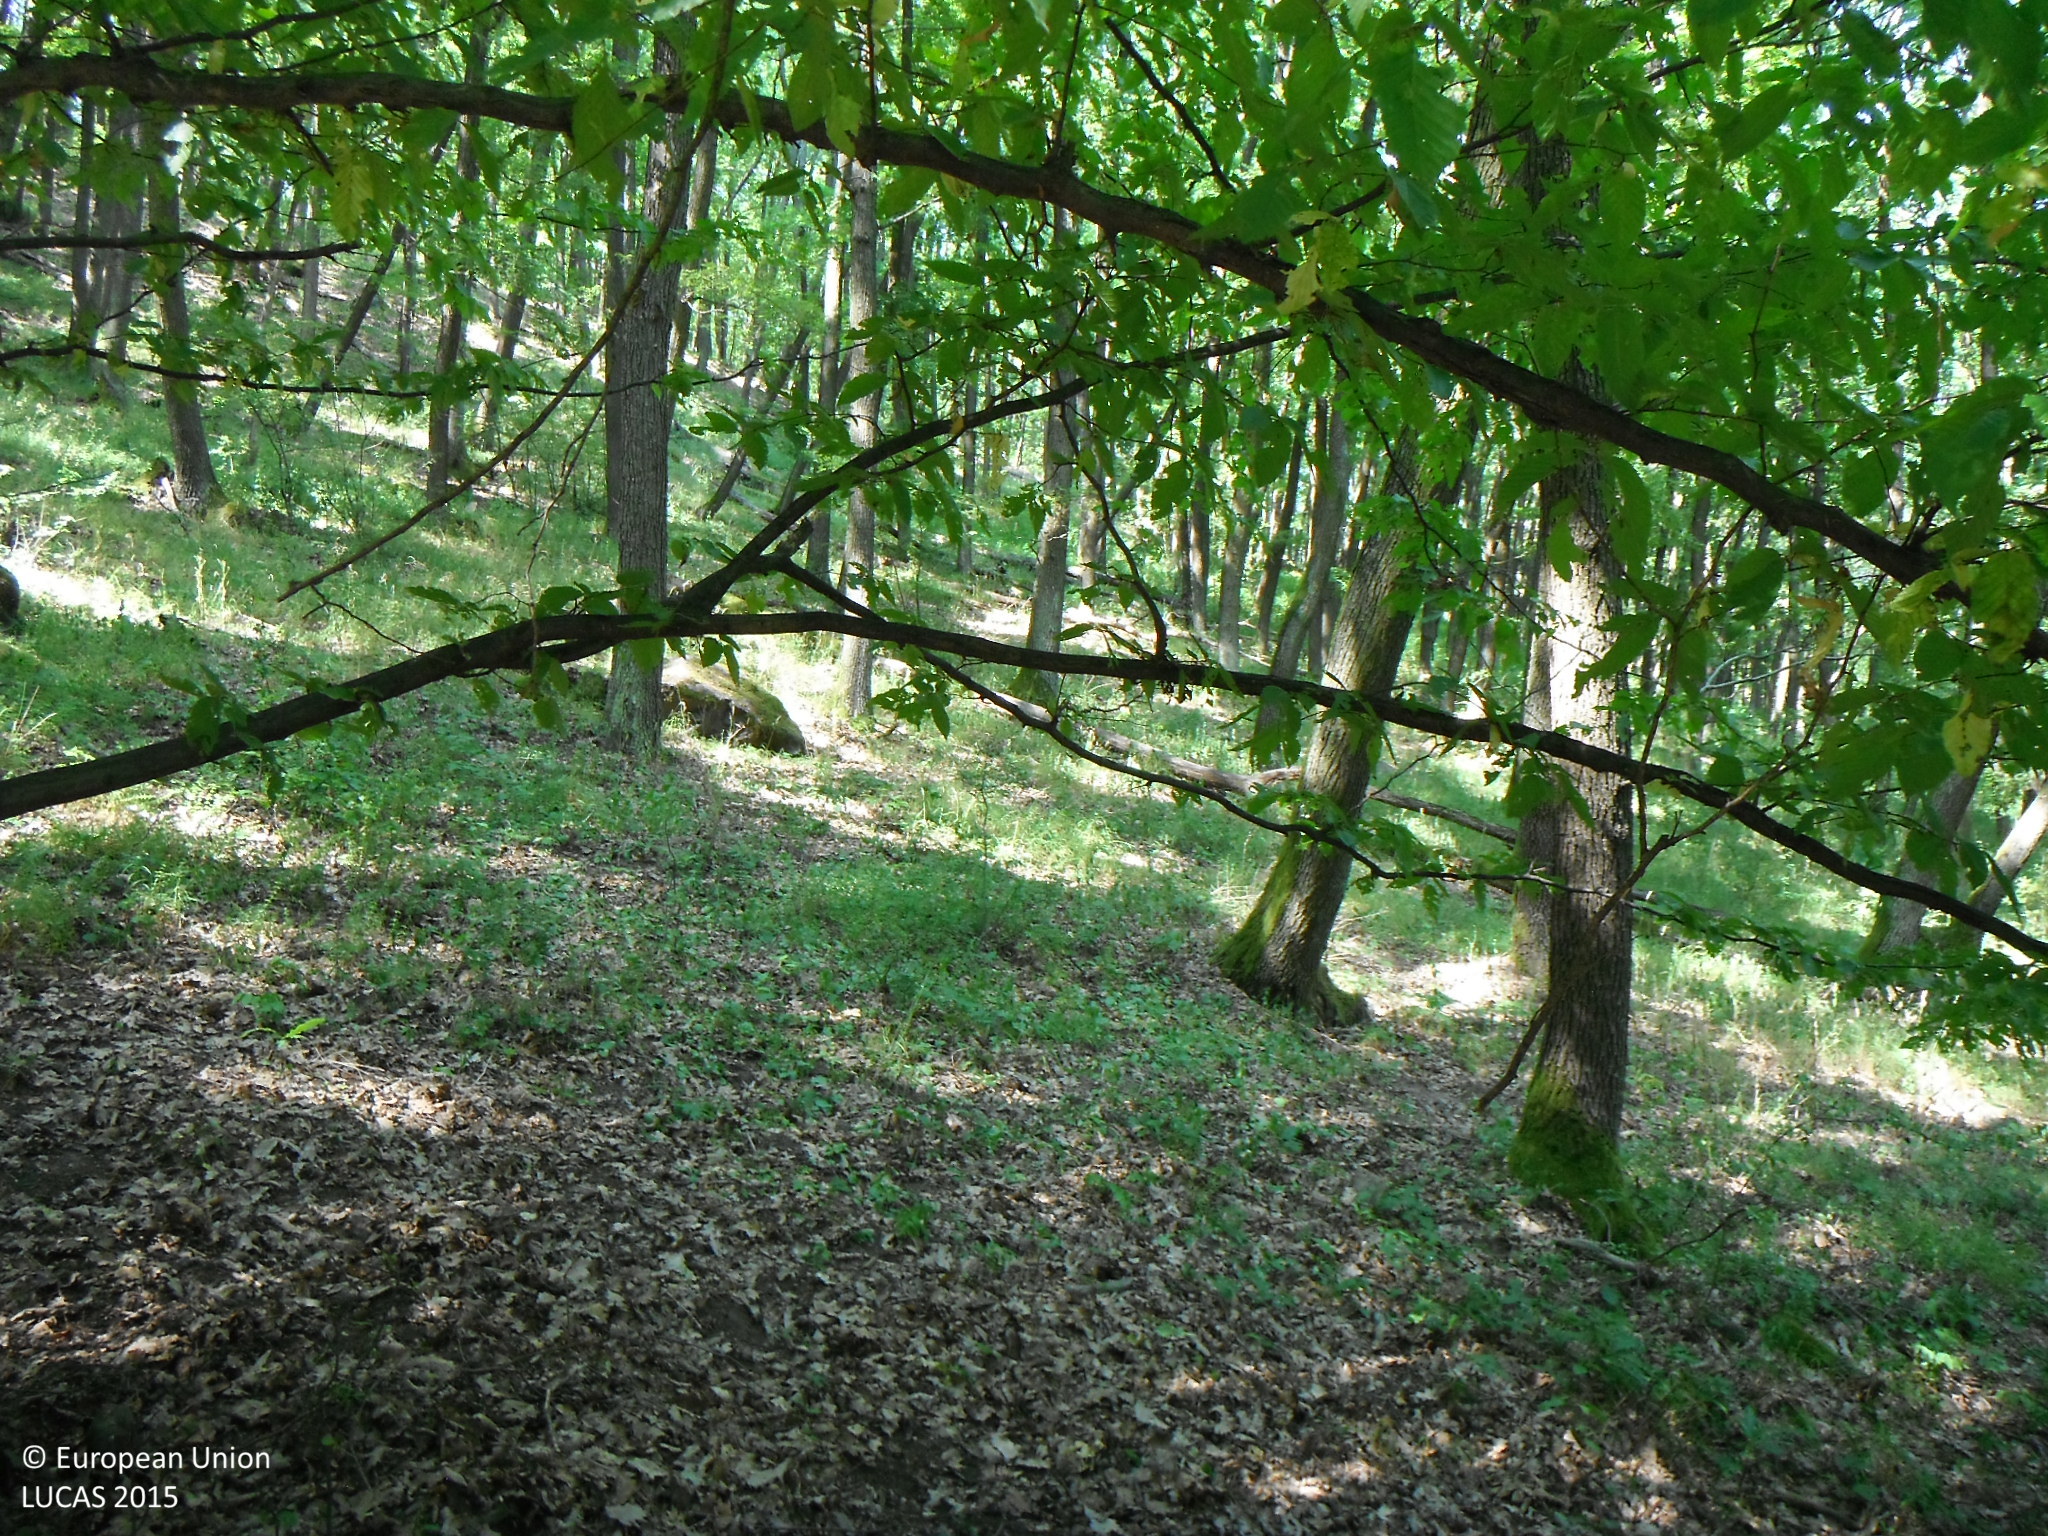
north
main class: Woodland
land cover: Broadleaved woodland
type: acidophilous oak and oak-birch forest
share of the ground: > 75 %
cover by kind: broadleaved forest trees 100 %
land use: Forestry
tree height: > 5 m
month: July
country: SK
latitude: 48.1370
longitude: 19.0910
